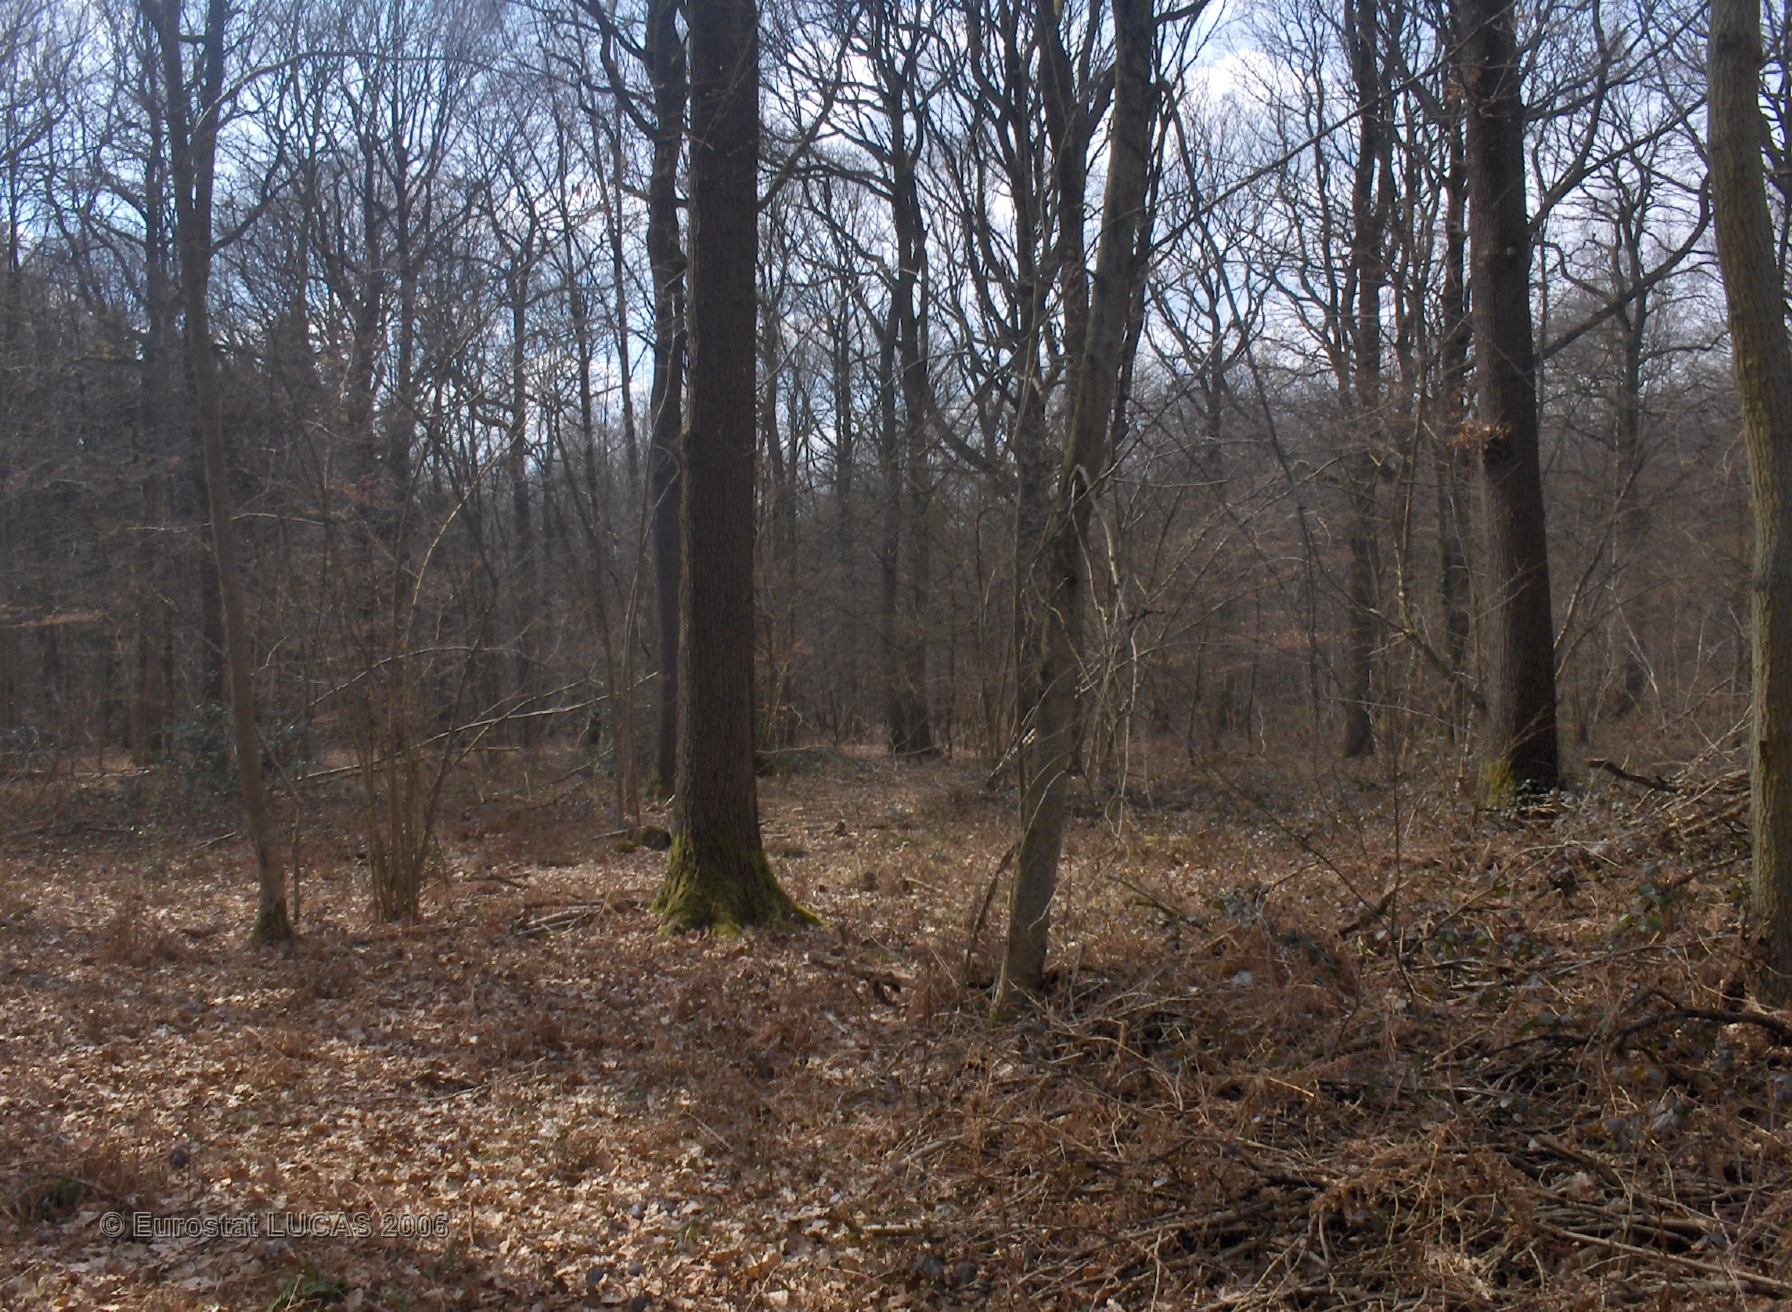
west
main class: Woodland
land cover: Mixed forest
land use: Forestry
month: April
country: BE
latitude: 50.3785
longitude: 4.5540
